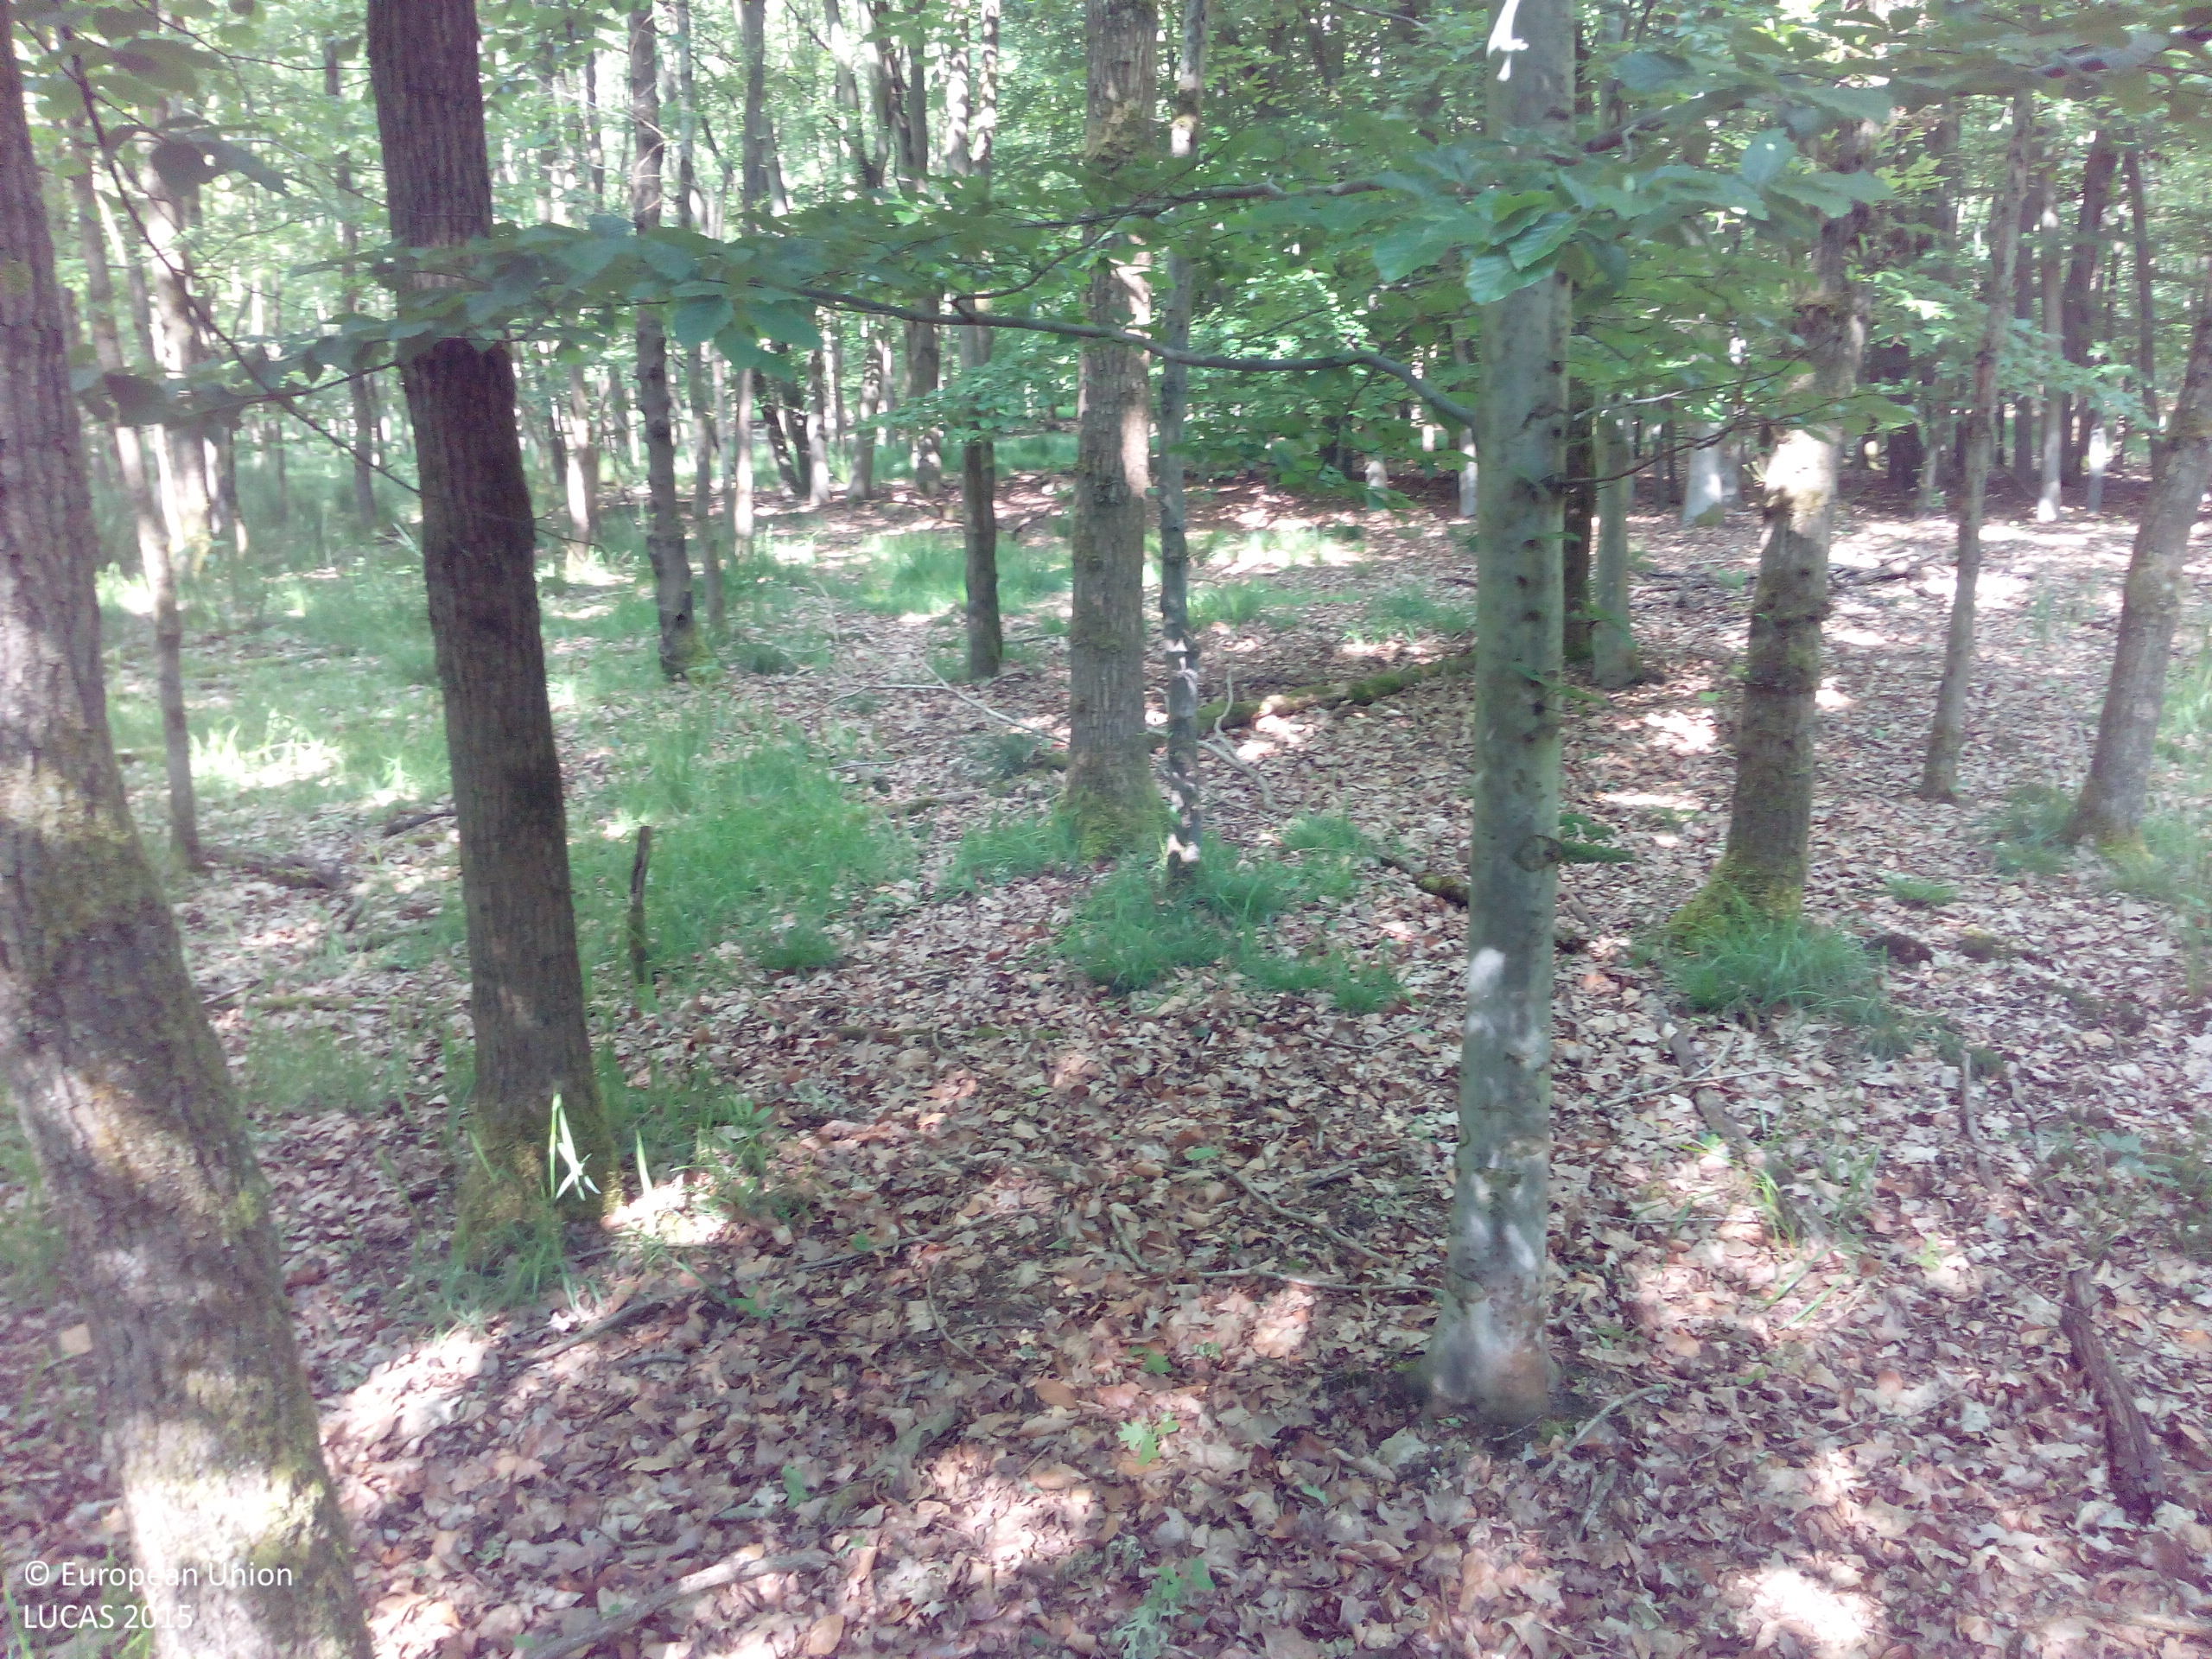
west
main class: Woodland
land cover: Broadleaved woodland
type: mesophytic deciduous forest
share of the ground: > 75 %
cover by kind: broadleaved forest trees 75 %, herbaceous plants 15 %, unconsolidated bare surface 10 %
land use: Forestry
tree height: > 5 m
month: May
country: DE
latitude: 49.9590
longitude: 8.5368
